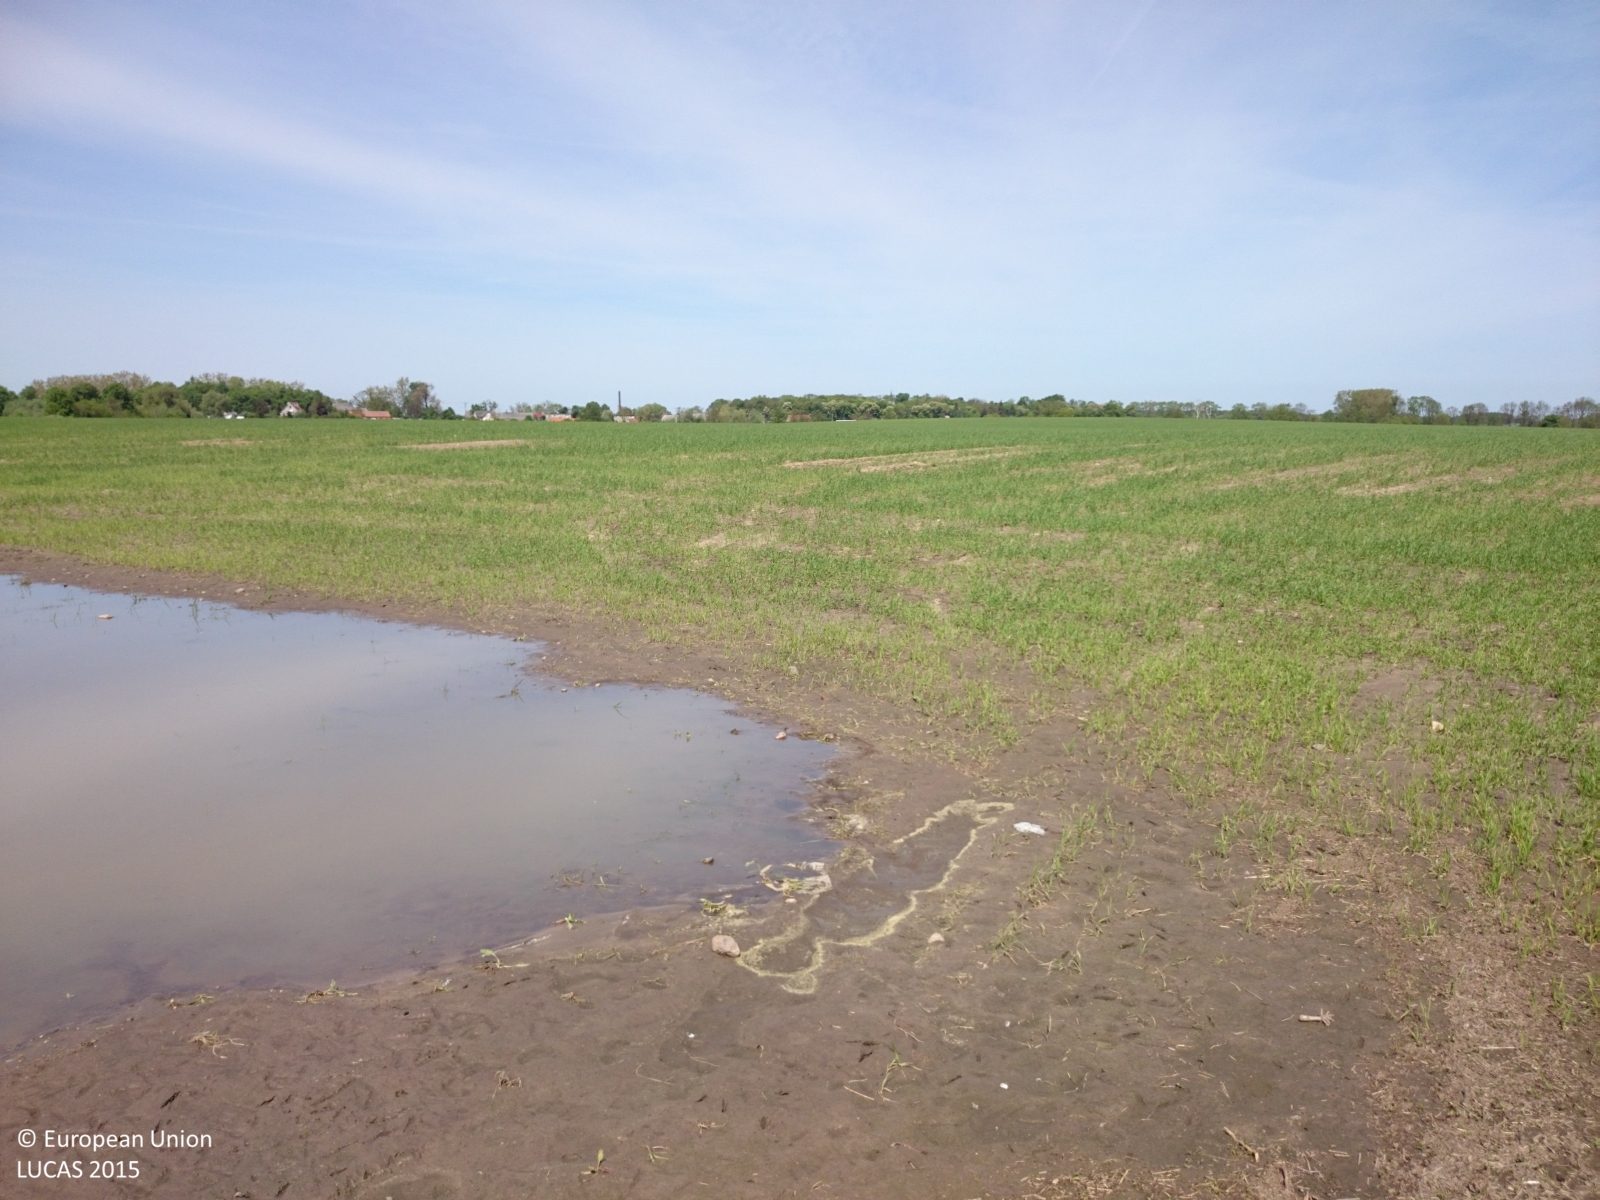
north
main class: Cropland
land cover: Rye
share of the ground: 10 - 25 %
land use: Agriculture (excluding fallow land and kitchen gardens)
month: May
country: PL
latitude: 52.4483
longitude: 16.2302
